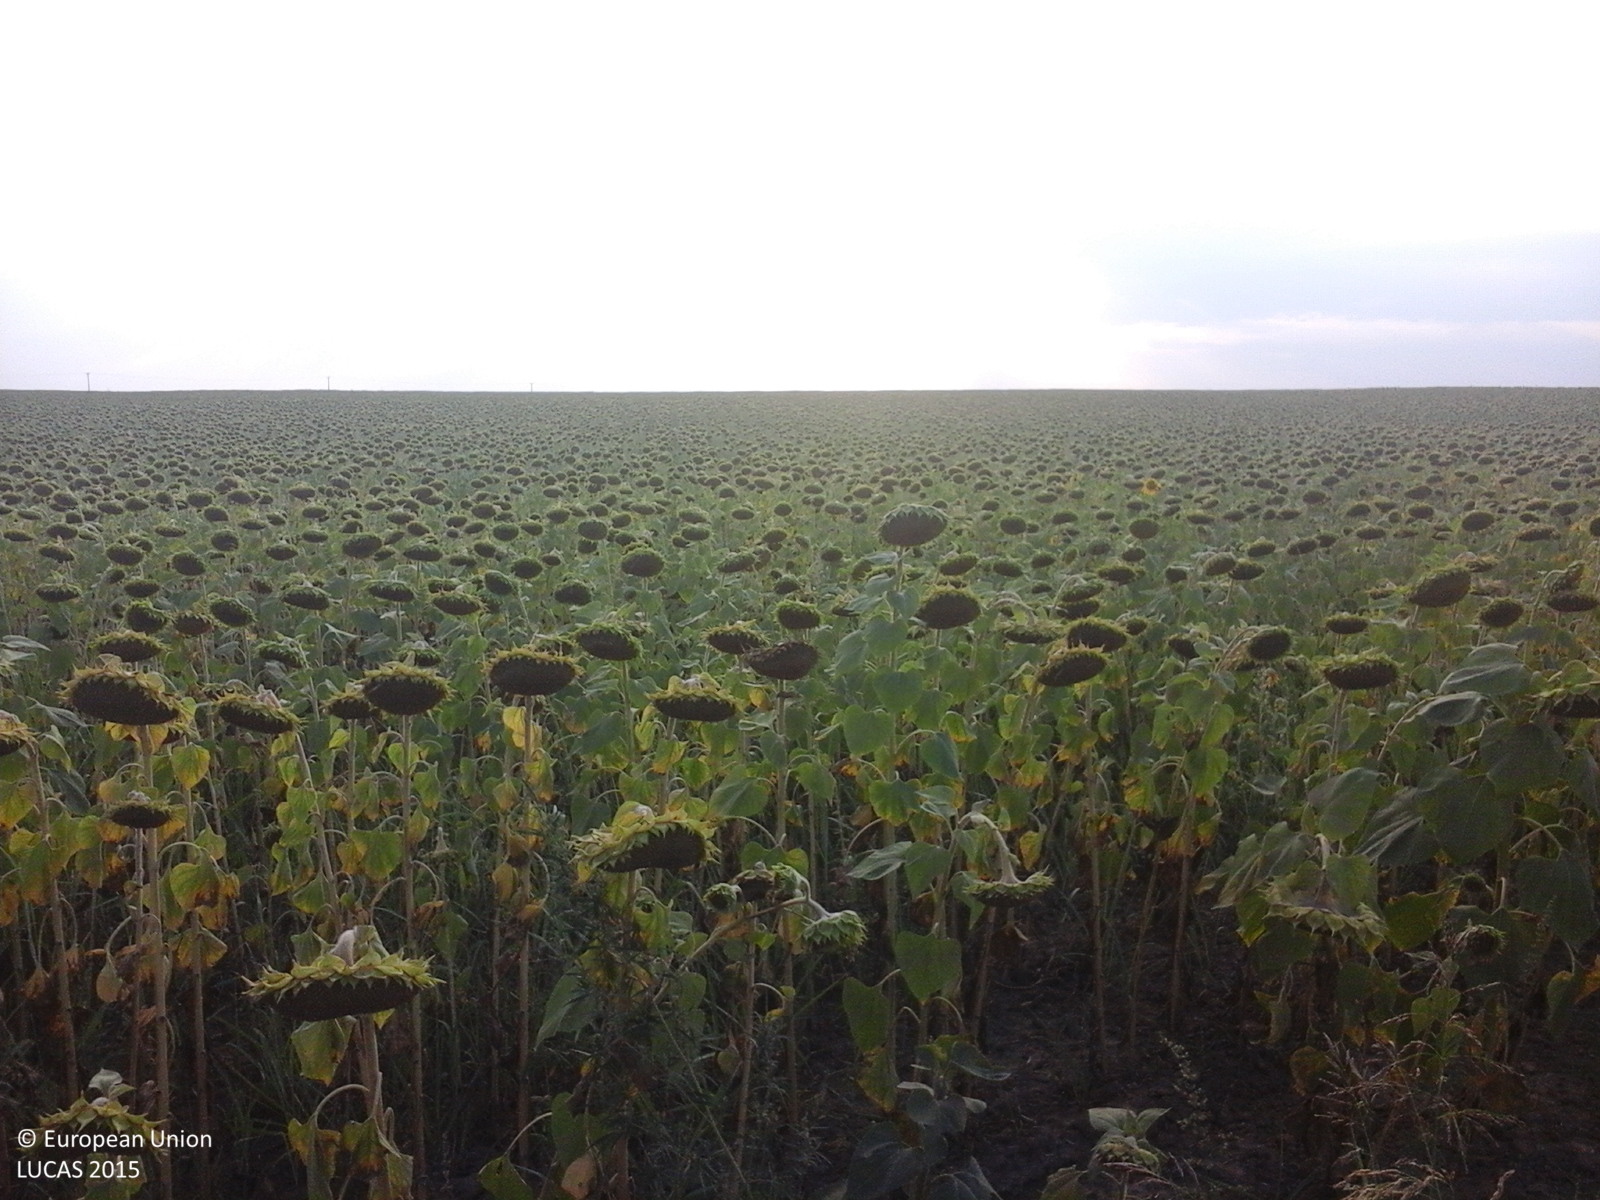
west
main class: Cropland
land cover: Sunflower
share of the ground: > 75 %
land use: Agriculture (excluding fallow land and kitchen gardens)
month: August
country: RO
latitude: 44.3981
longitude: 28.1270
